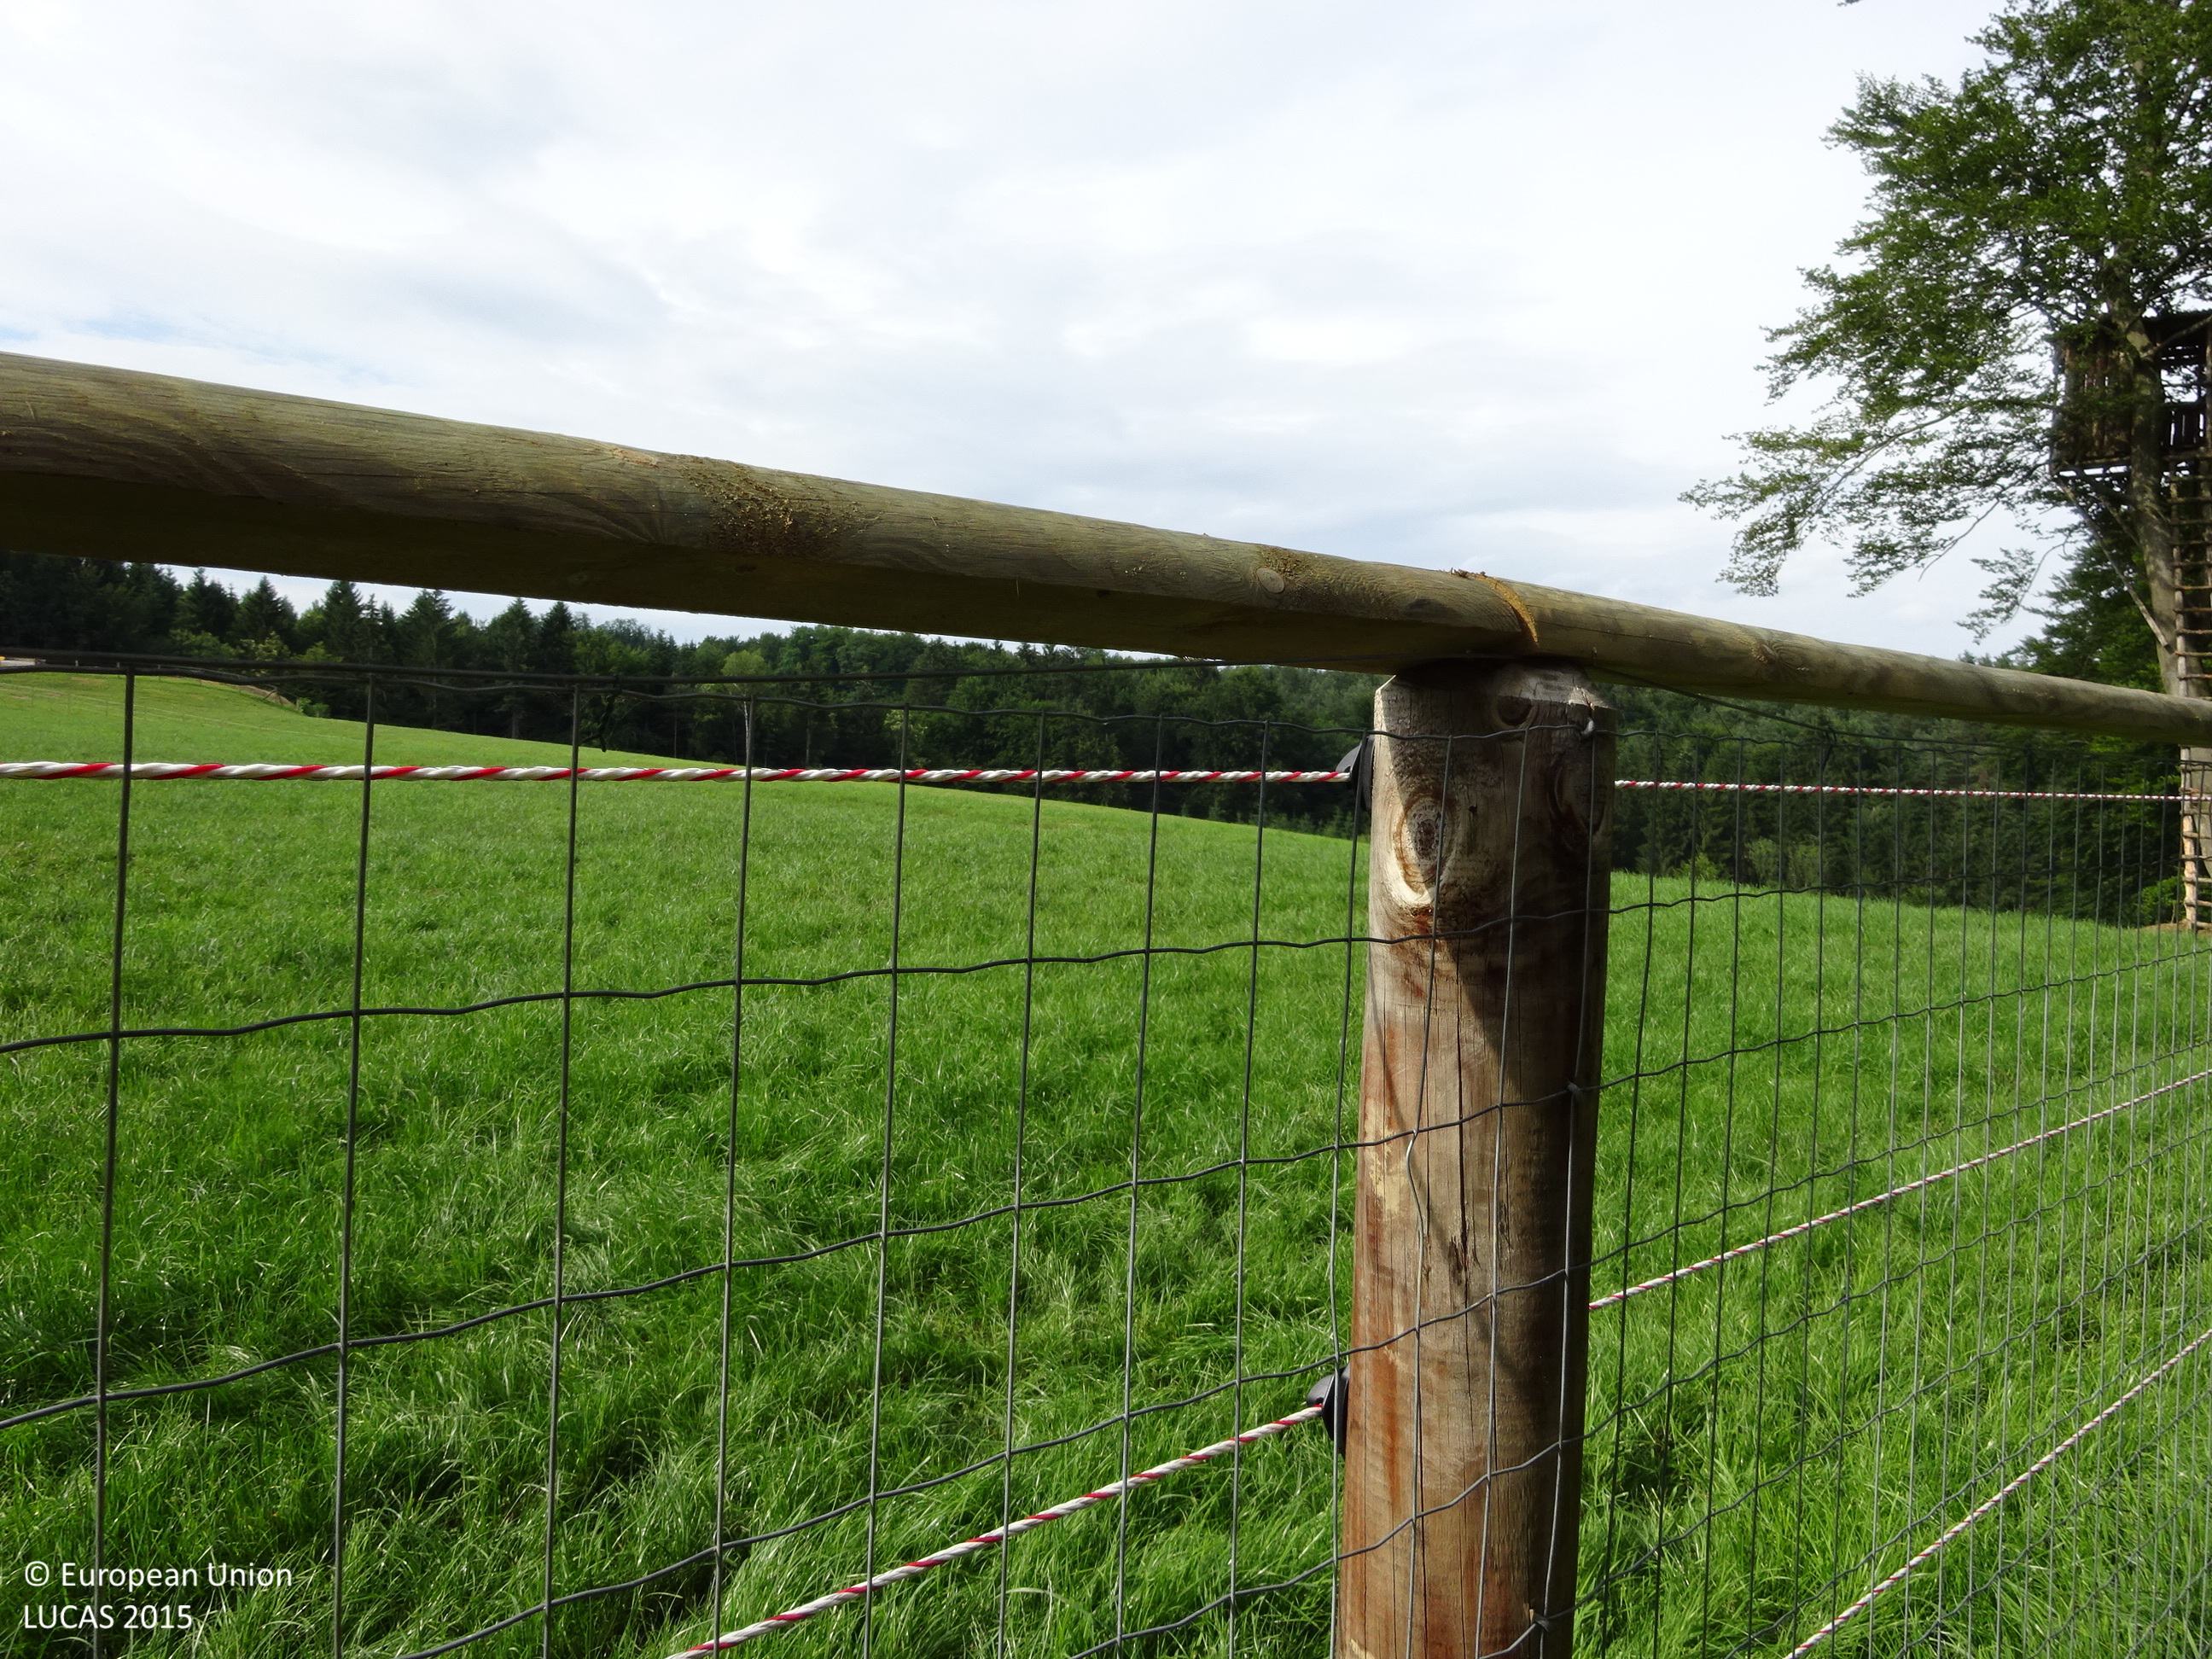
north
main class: Grassland
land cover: Grassland without tree/shrub cover
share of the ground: > 75 %
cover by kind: herbaceous plants 100 %
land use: Agriculture (excluding fallow land and kitchen gardens)
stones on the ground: < 10 %
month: June
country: AT
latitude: 46.7265
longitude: 15.2719
